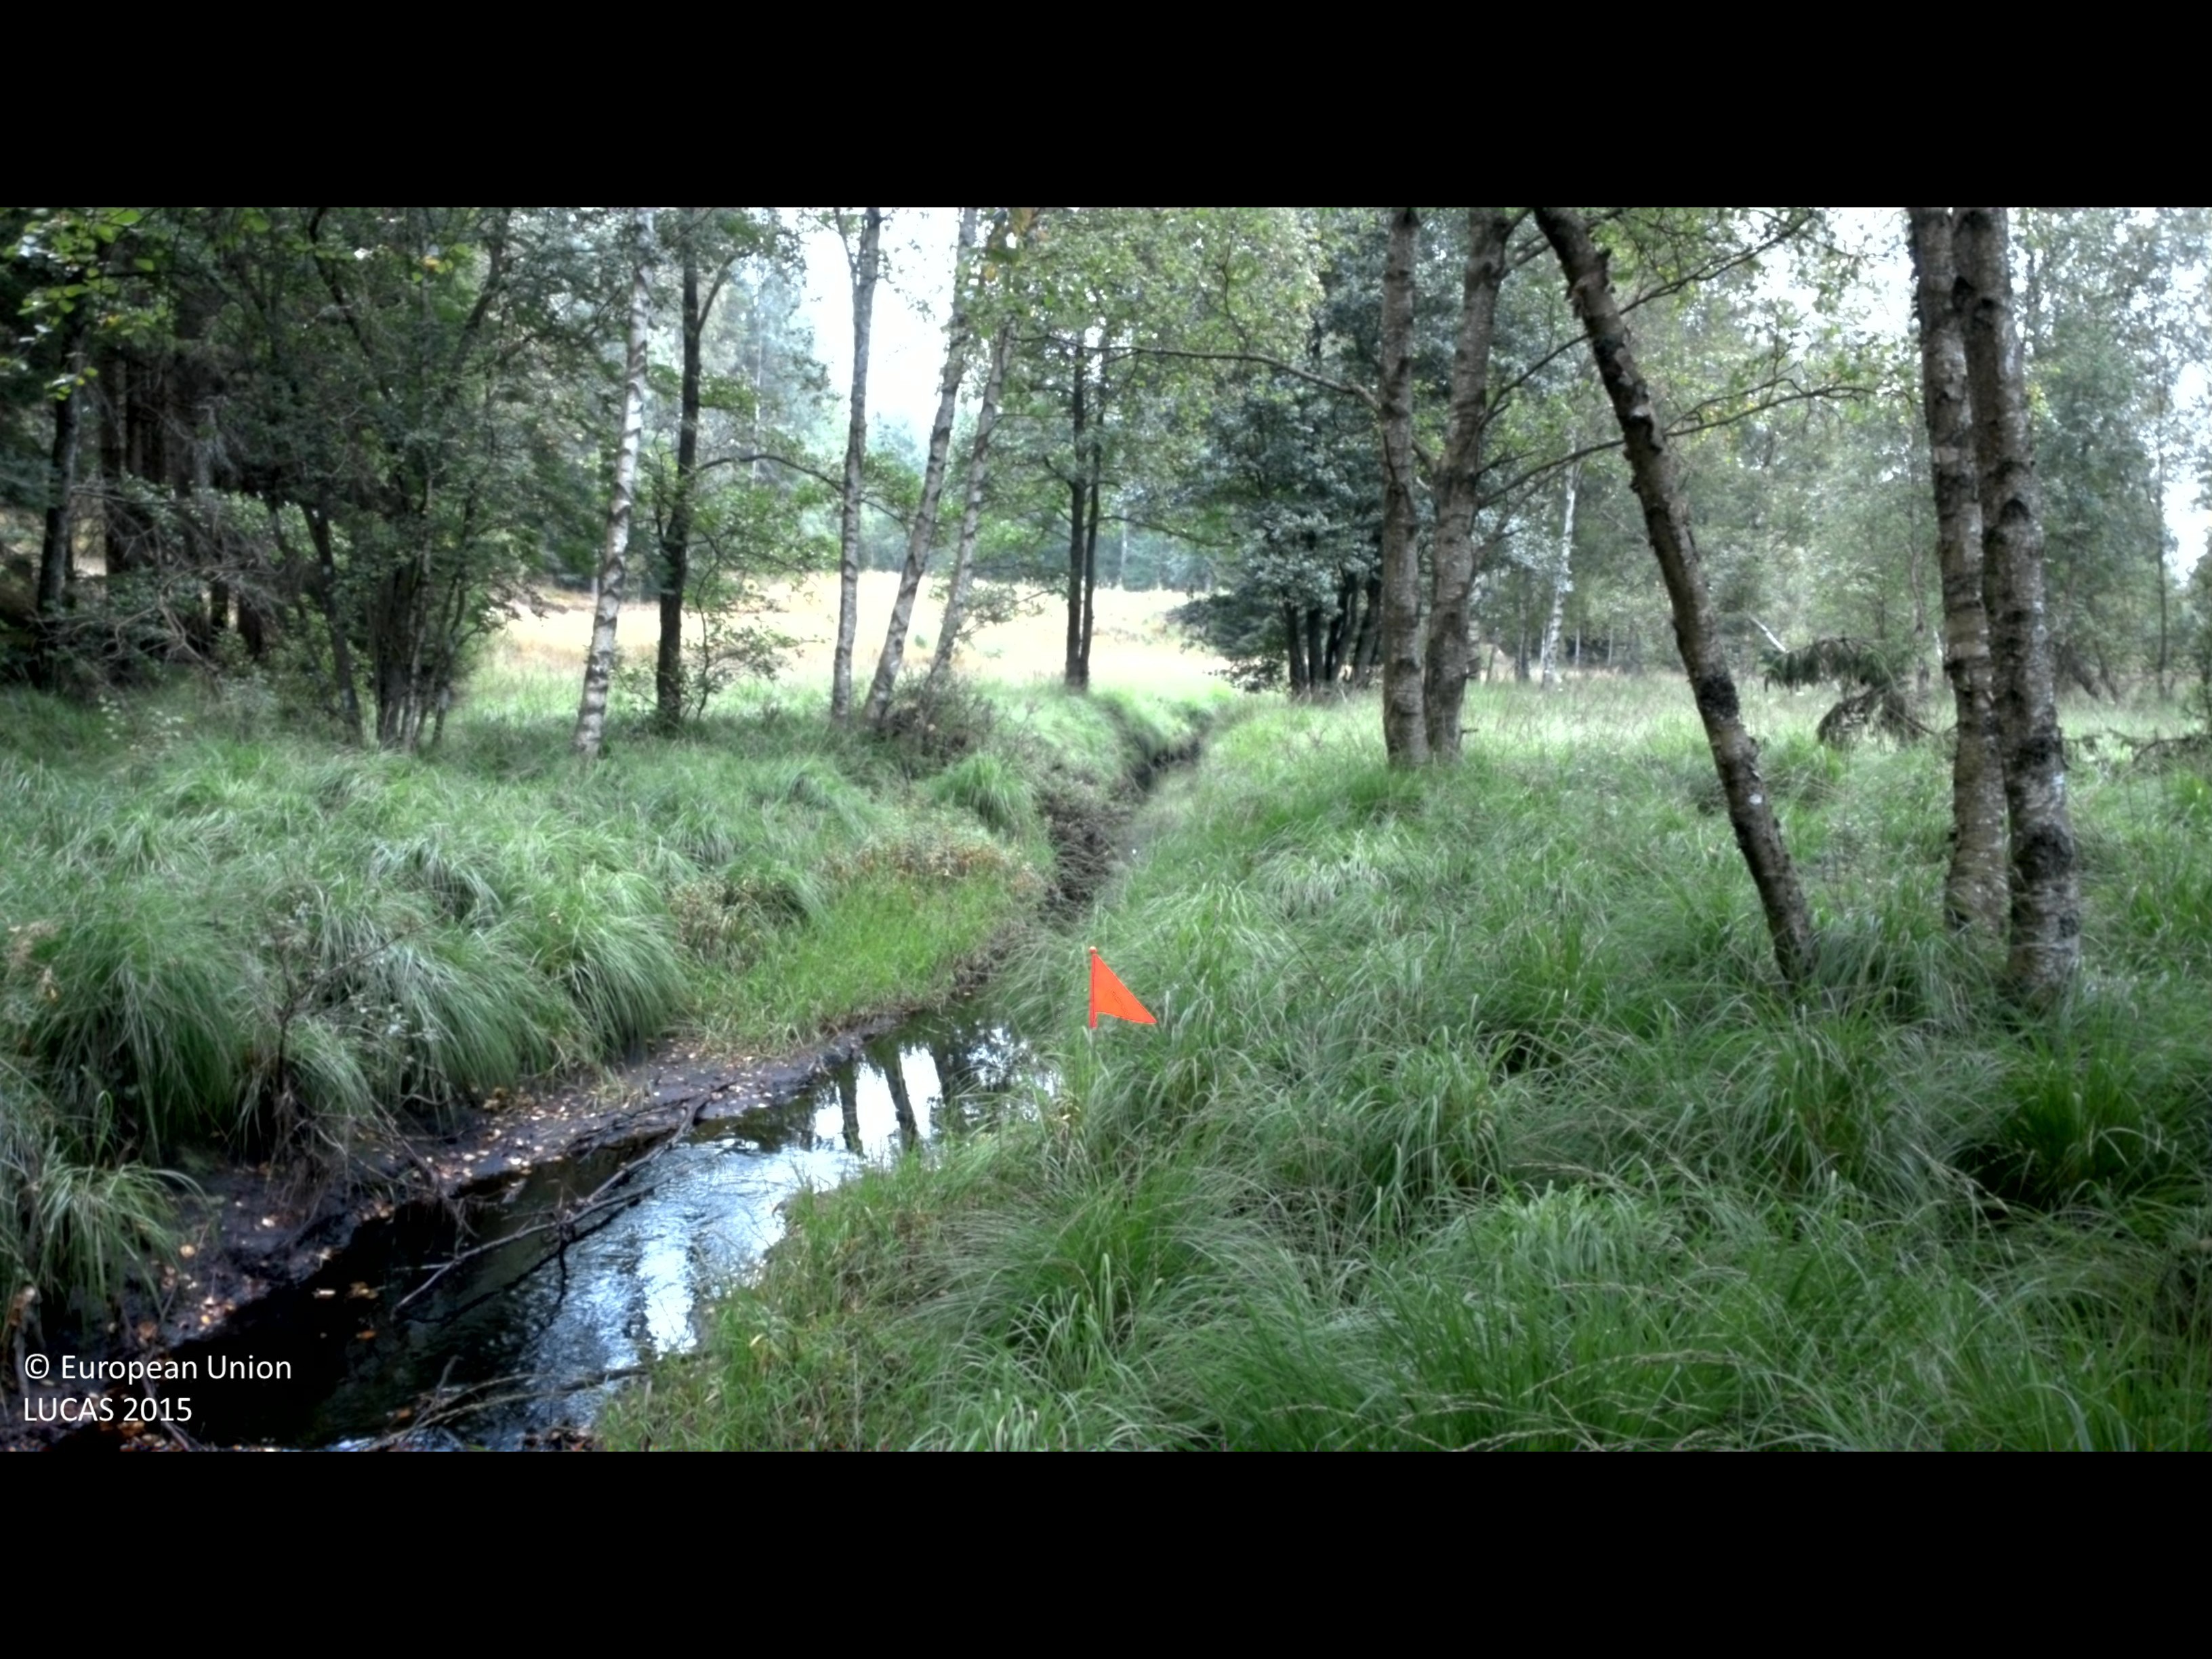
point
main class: Woodland
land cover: Broadleaved woodland
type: boreal forest
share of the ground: 25 - 50 %
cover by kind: herbaceous plants 55 %, broadleaved forest trees 40 %, shrubs 5 %
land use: Semi-natural and natural areas not in use
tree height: > 5 m
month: August
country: SE
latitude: 56.9232
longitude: 13.1344
